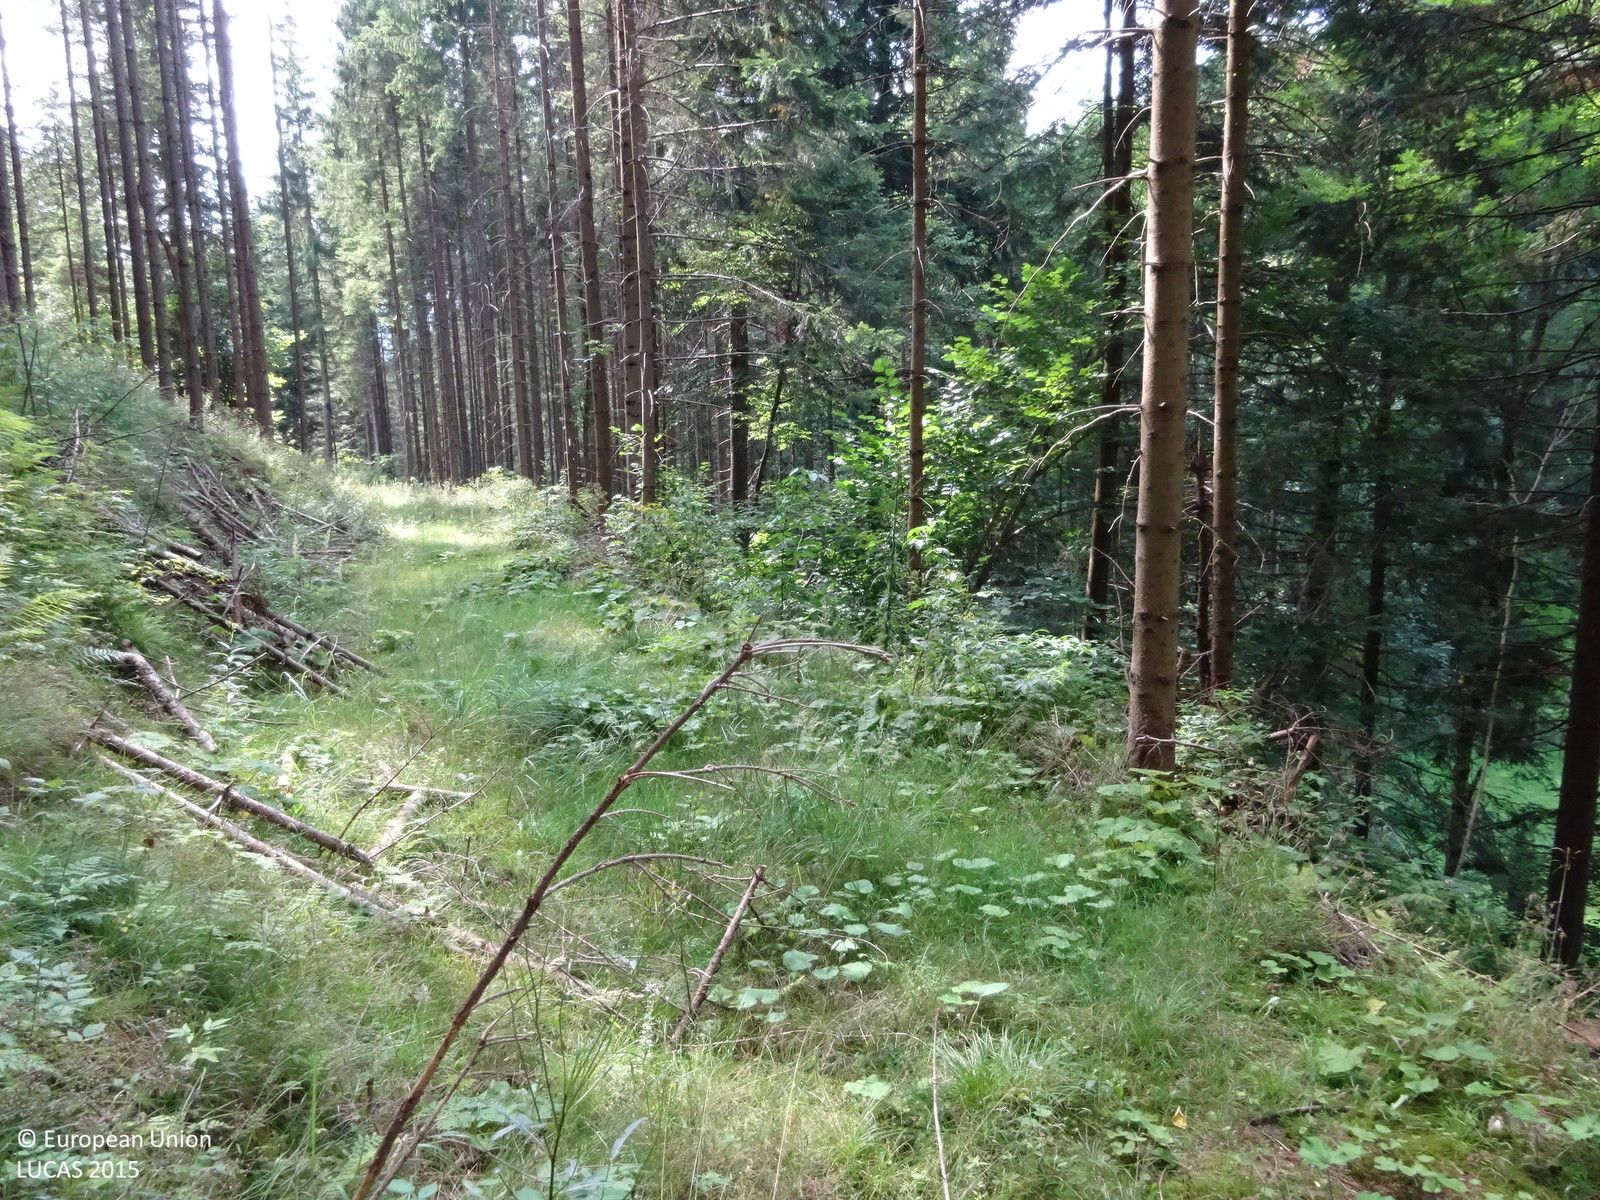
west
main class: Woodland
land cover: Spruce dominated coniferous woodland
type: alpine coniferous forest
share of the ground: > 75 %
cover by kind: coniferous forest trees 90 %, herbaceous plants 10 %
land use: Forestry
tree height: > 5 m
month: August
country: AT
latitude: 47.4617
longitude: 15.7188
